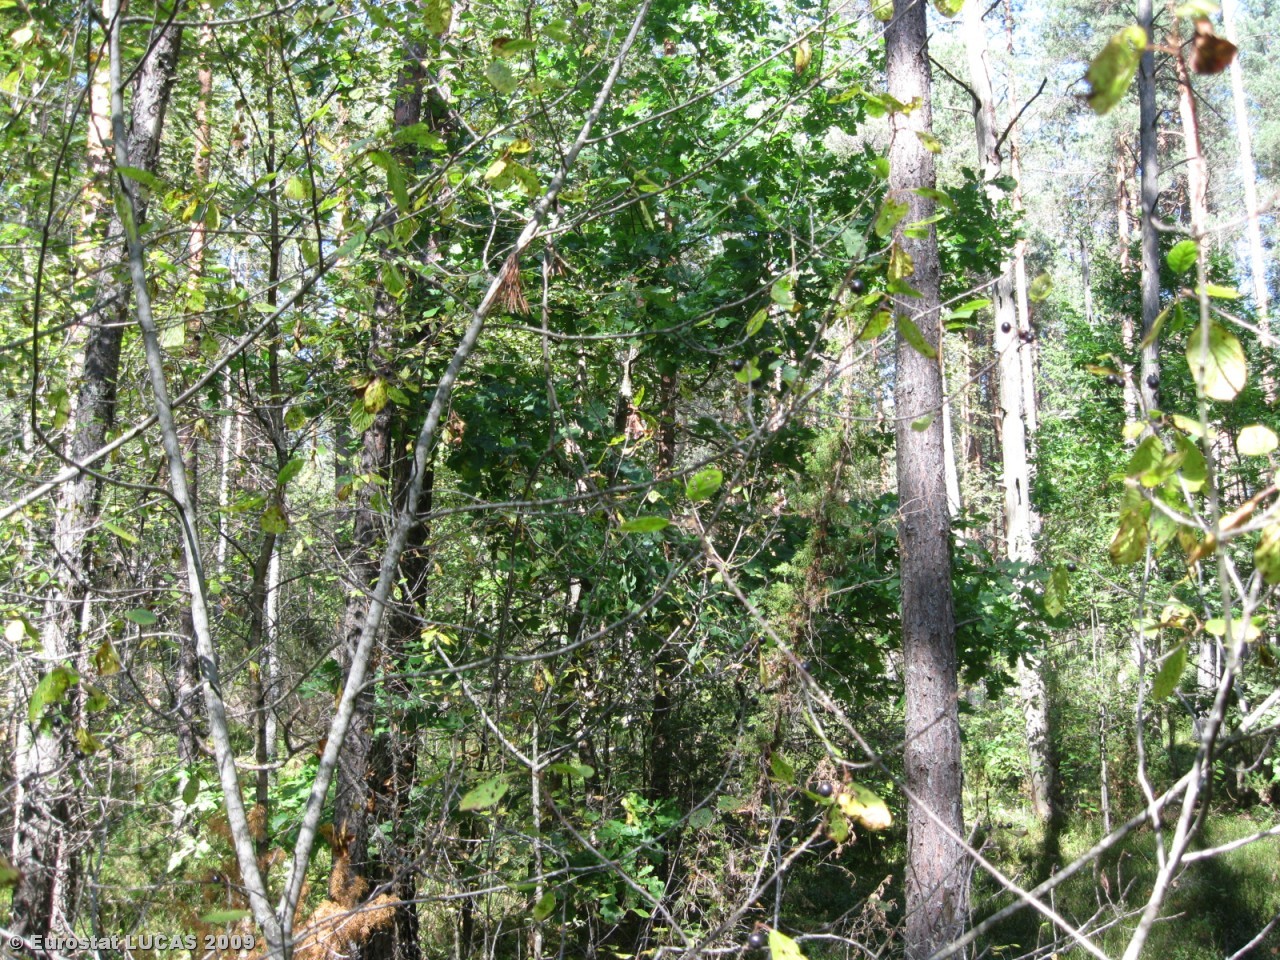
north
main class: Woodland
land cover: Mixed woodland
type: hemiboreal forest and nemoral coniferous forest and mixed broadleaved-coniferous forest
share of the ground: > 75 %
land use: Forestry
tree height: > 5 m
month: August
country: LT
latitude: 54.3173
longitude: 24.6338
